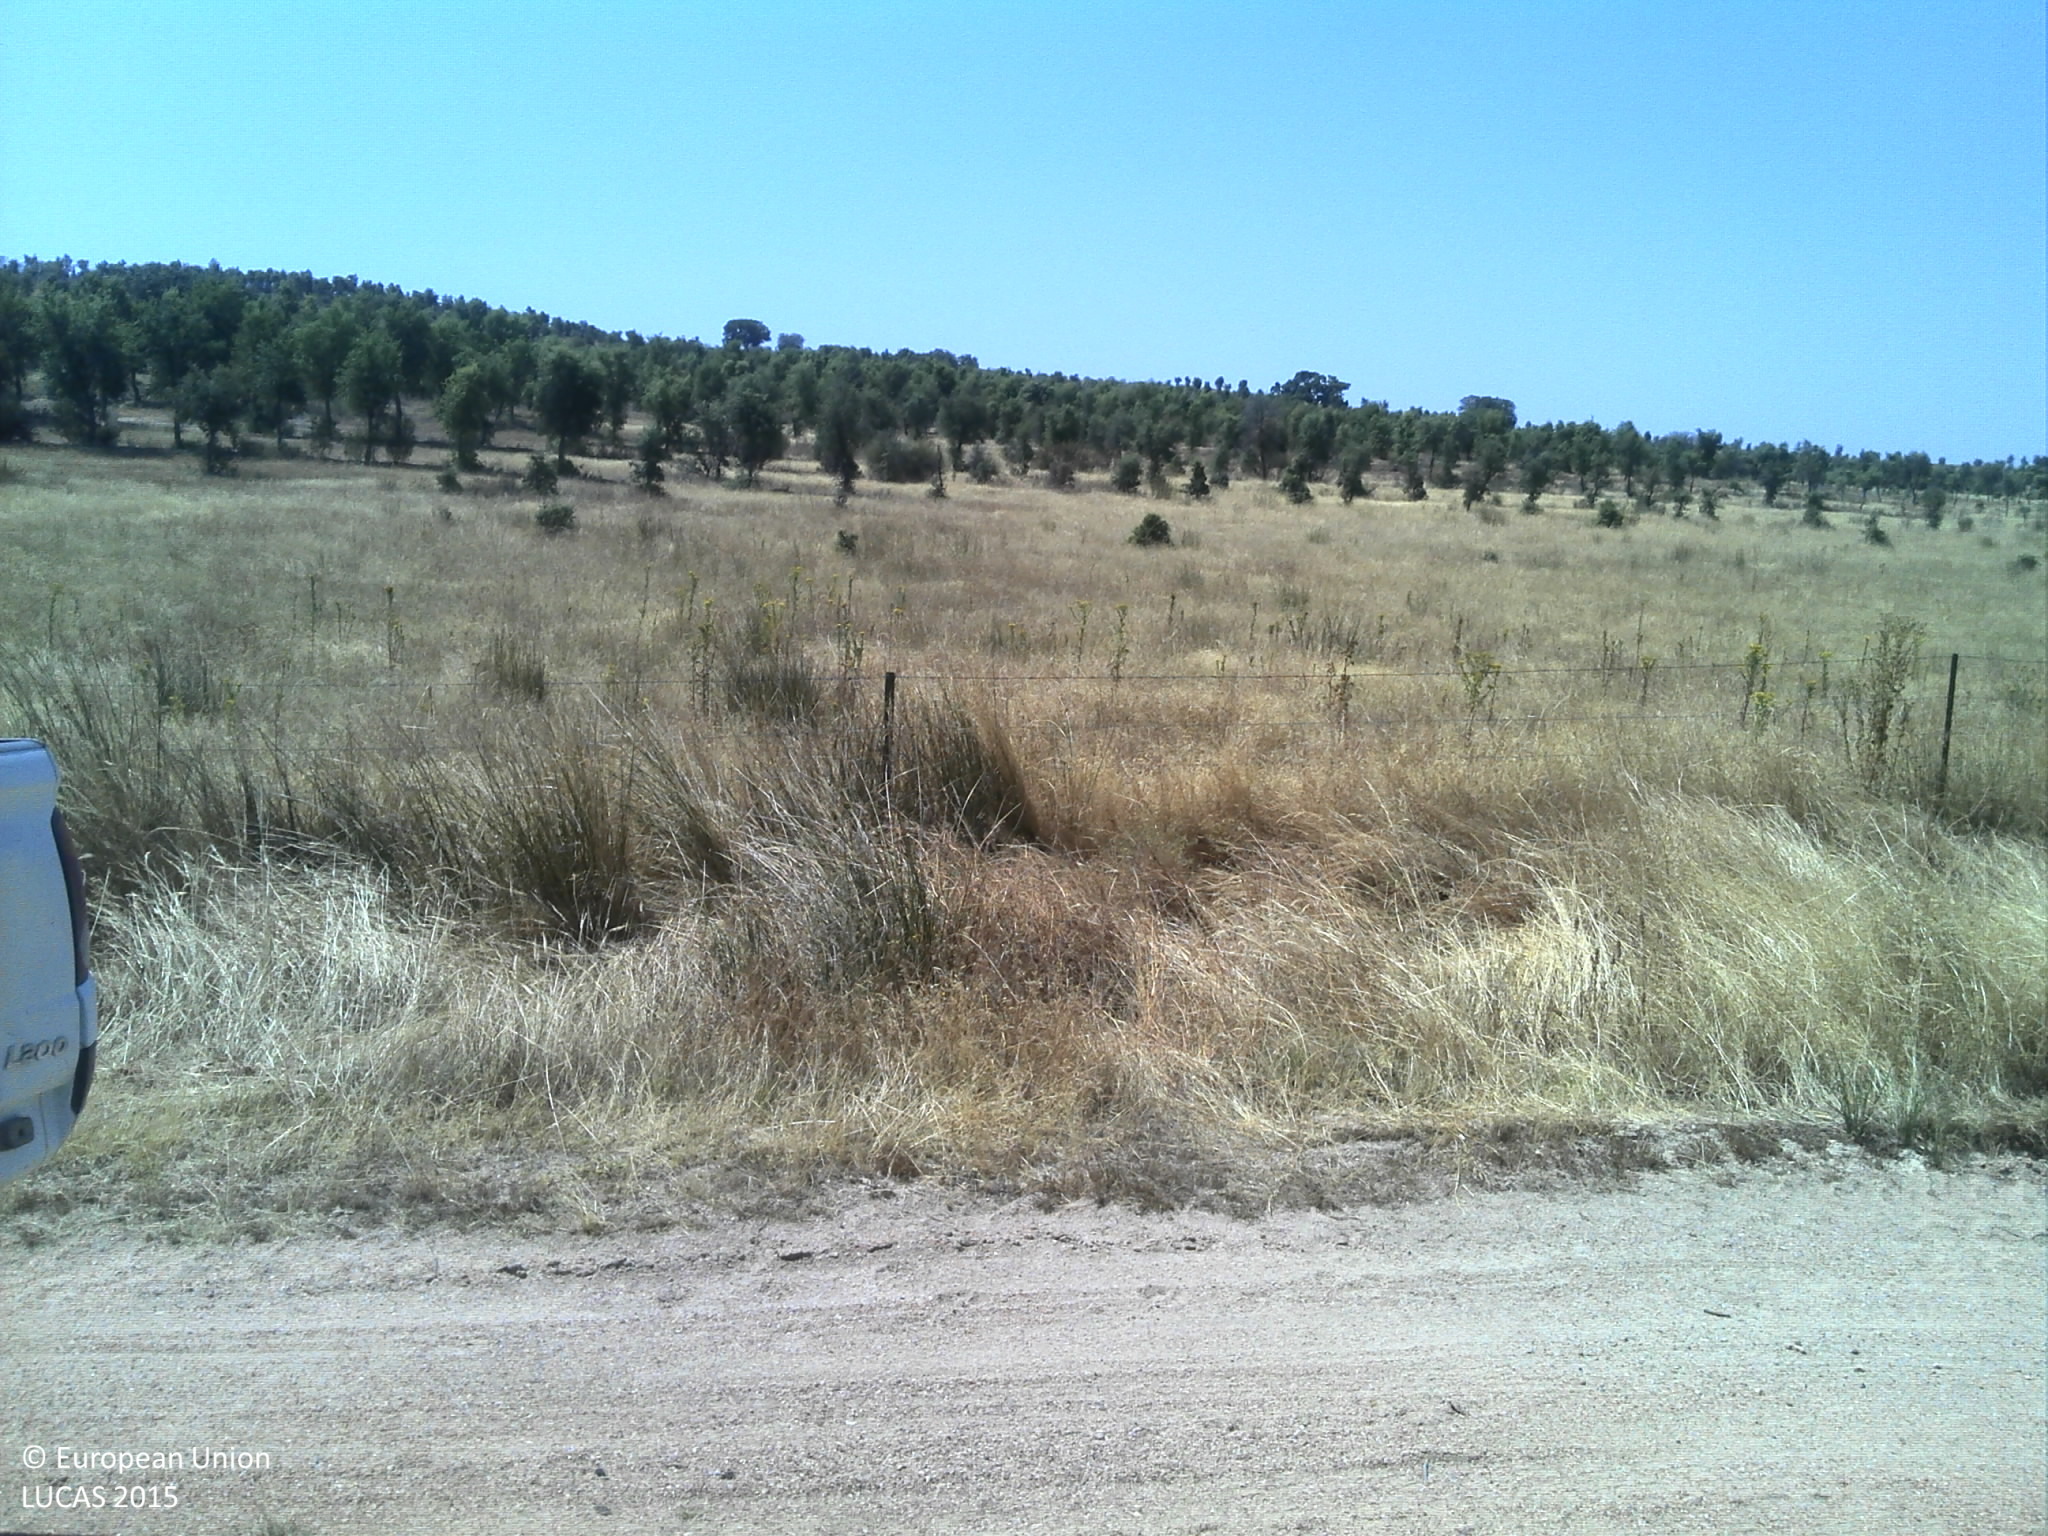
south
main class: Grassland
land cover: Grassland with sparse tree/shrub cover
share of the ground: 50 - 75 %
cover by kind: herbaceous plants 85 %, shrubs 10 %, broadleaved forest trees 5 %
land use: Agriculture (excluding fallow land and kitchen gardens)
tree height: > 5 m
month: June
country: PT
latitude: 39.7656
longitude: -7.2164
